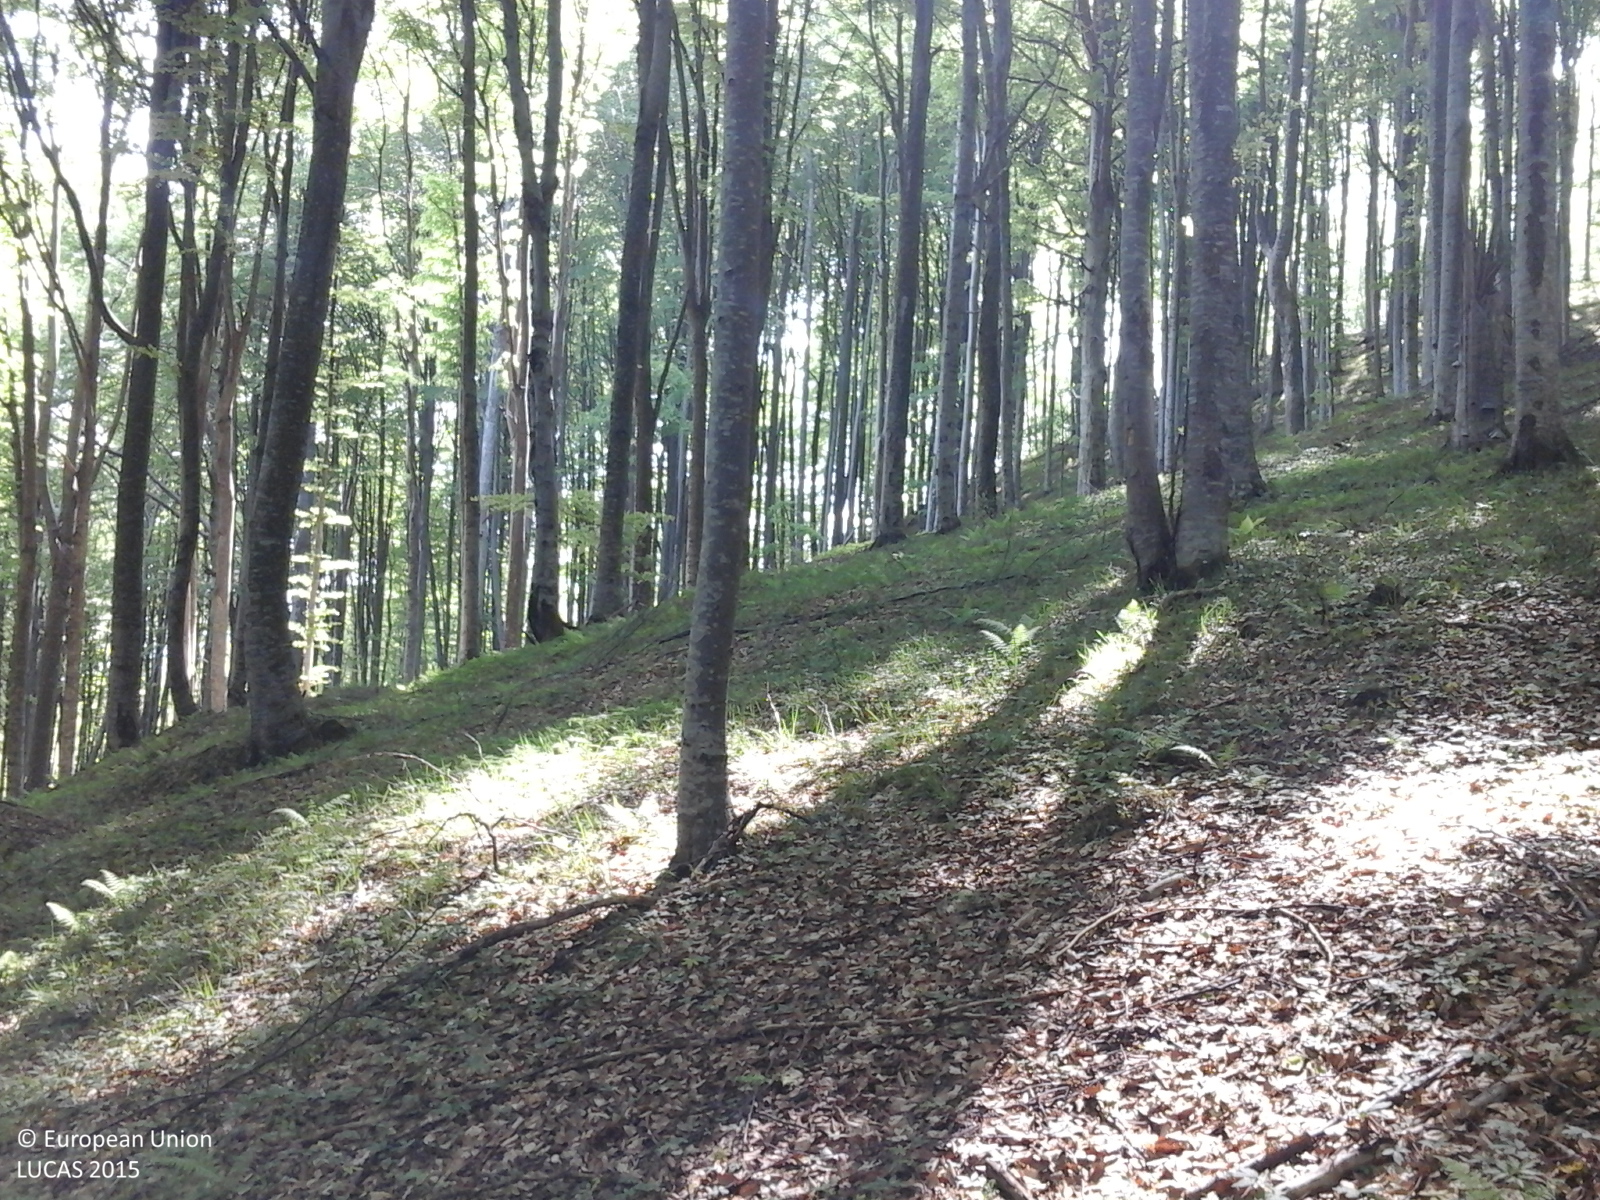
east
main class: Woodland
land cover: Broadleaved woodland
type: beech forest
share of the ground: > 75 %
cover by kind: broadleaved forest trees 100 %
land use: Forestry
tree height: > 5 m
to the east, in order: Broadleaved woodland
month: May
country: RO
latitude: 45.7266
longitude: 25.9832
